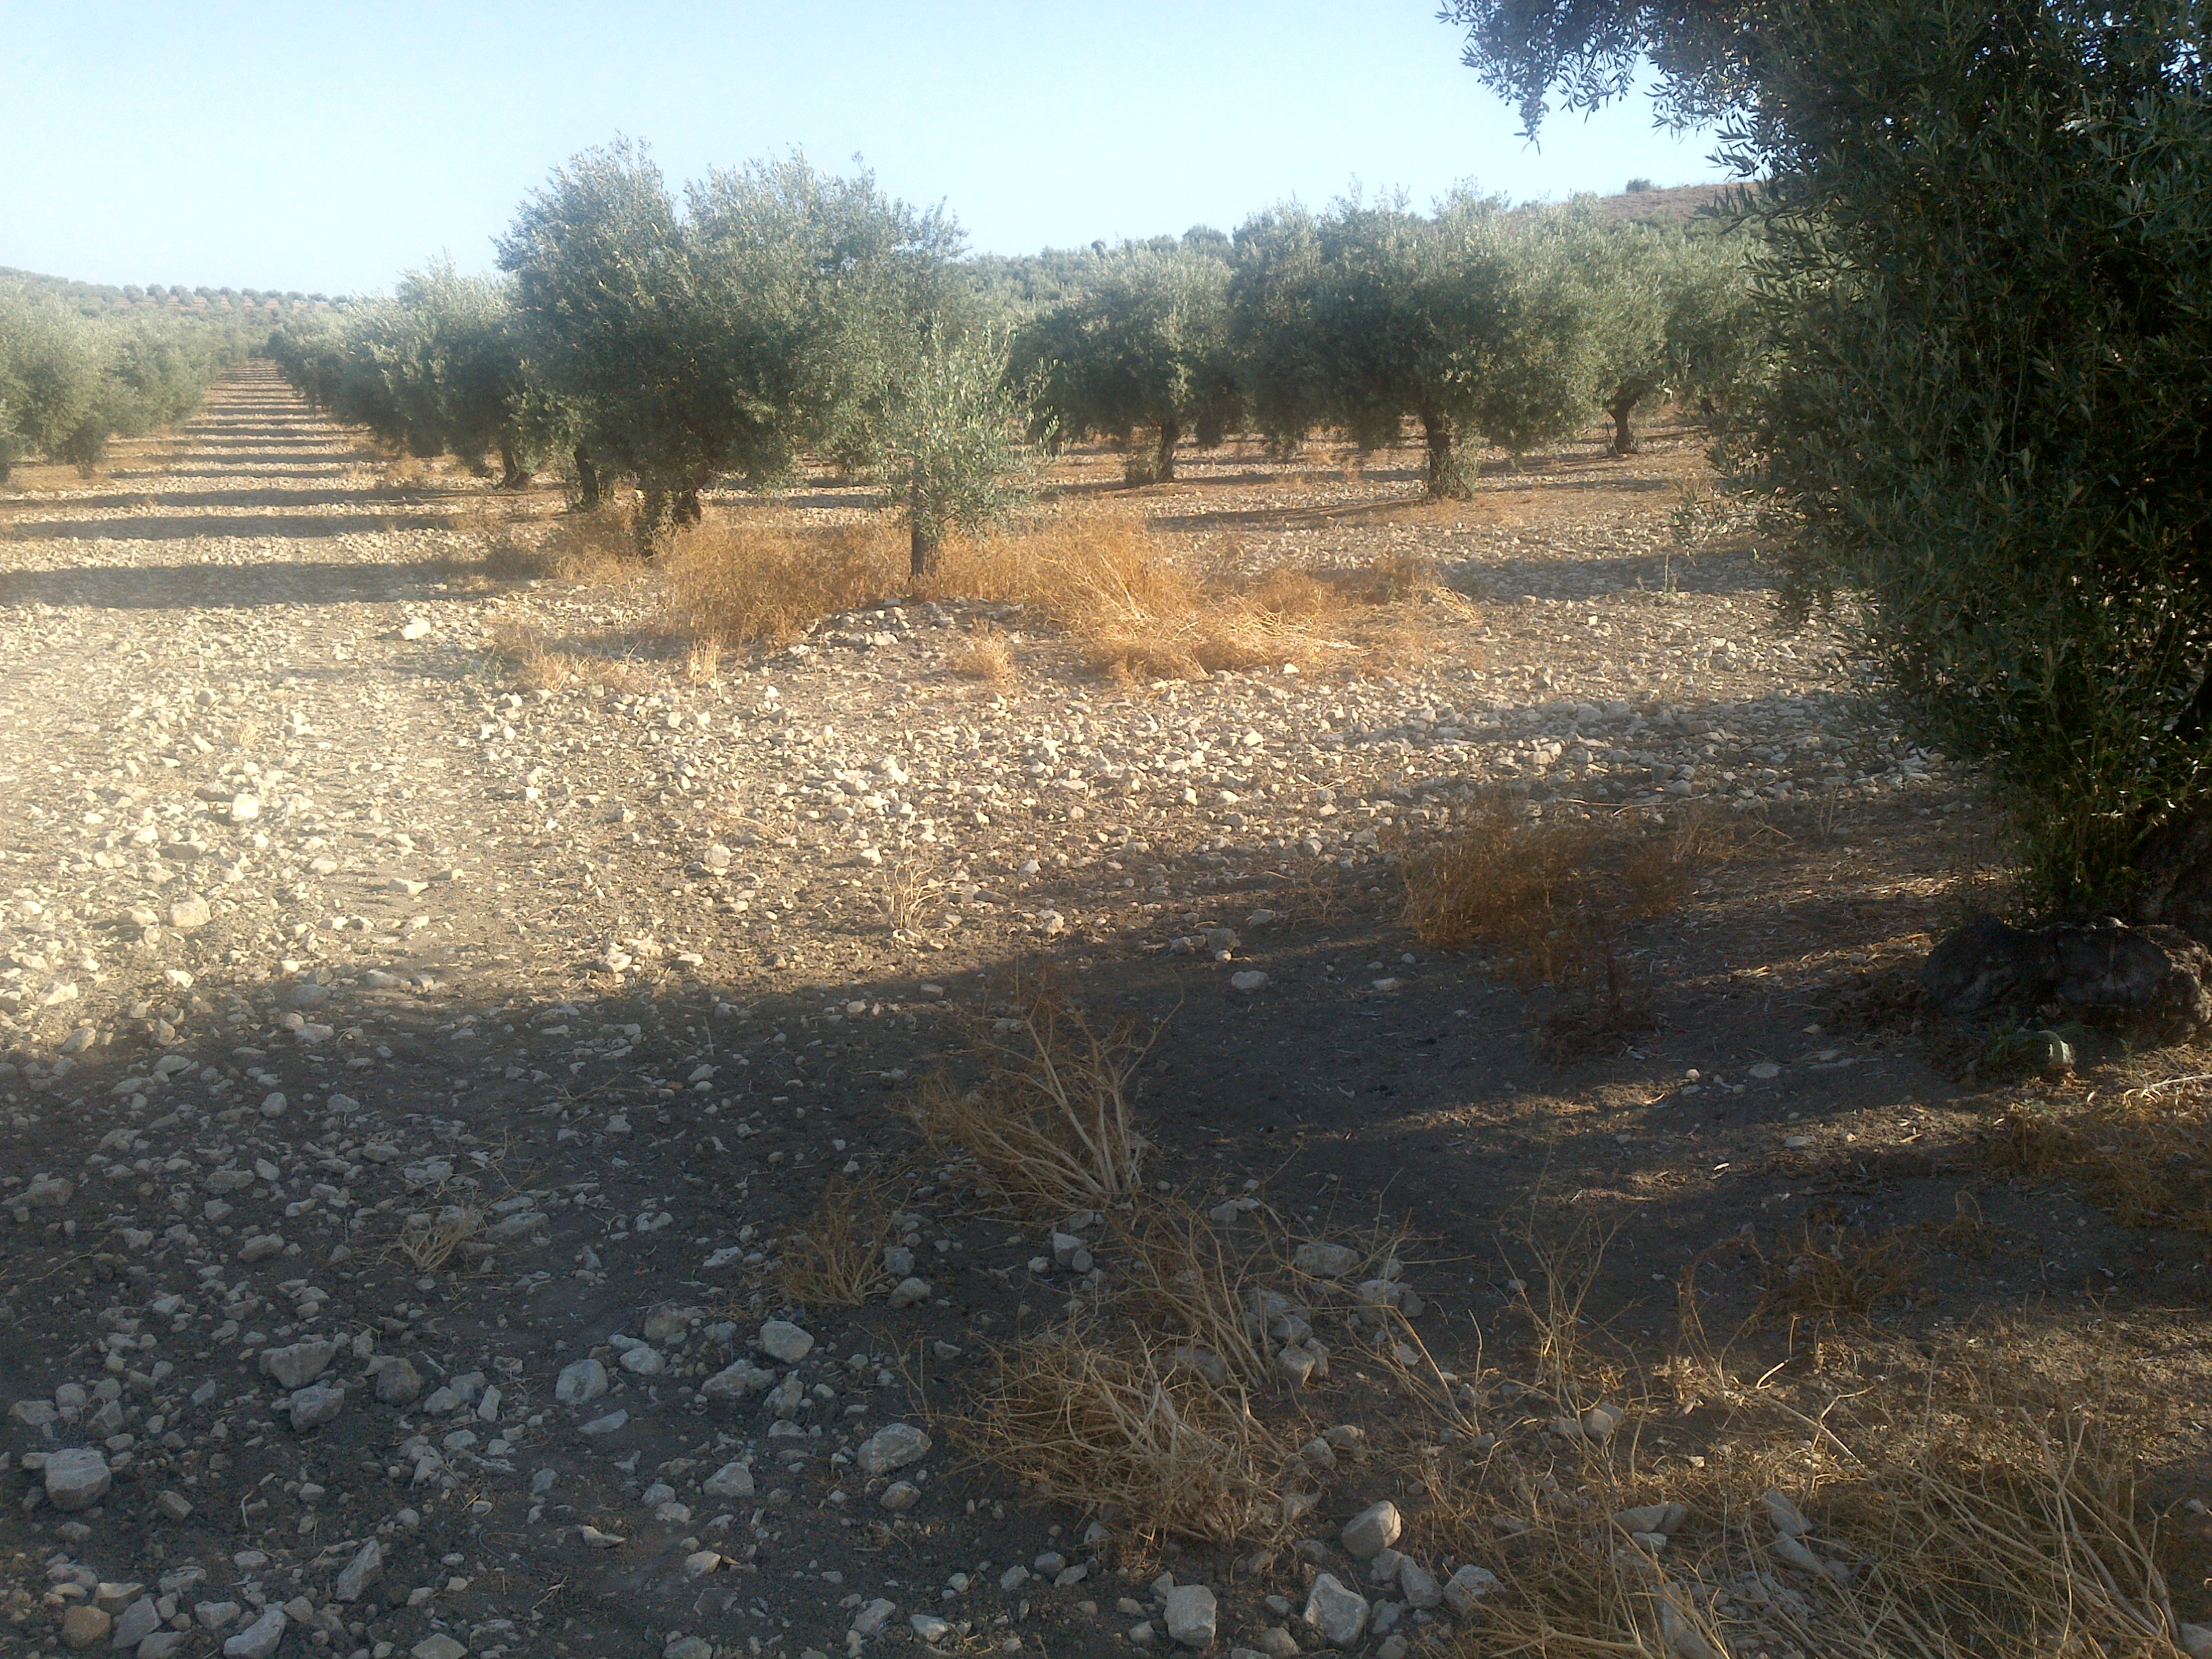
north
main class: Cropland
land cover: Olive groves
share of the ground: 50 - 75 %
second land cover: Other bare soil
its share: > 75 %
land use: Agriculture (excluding fallow land and kitchen gardens)
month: June
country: ES
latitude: 37.6901
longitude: -4.4201
